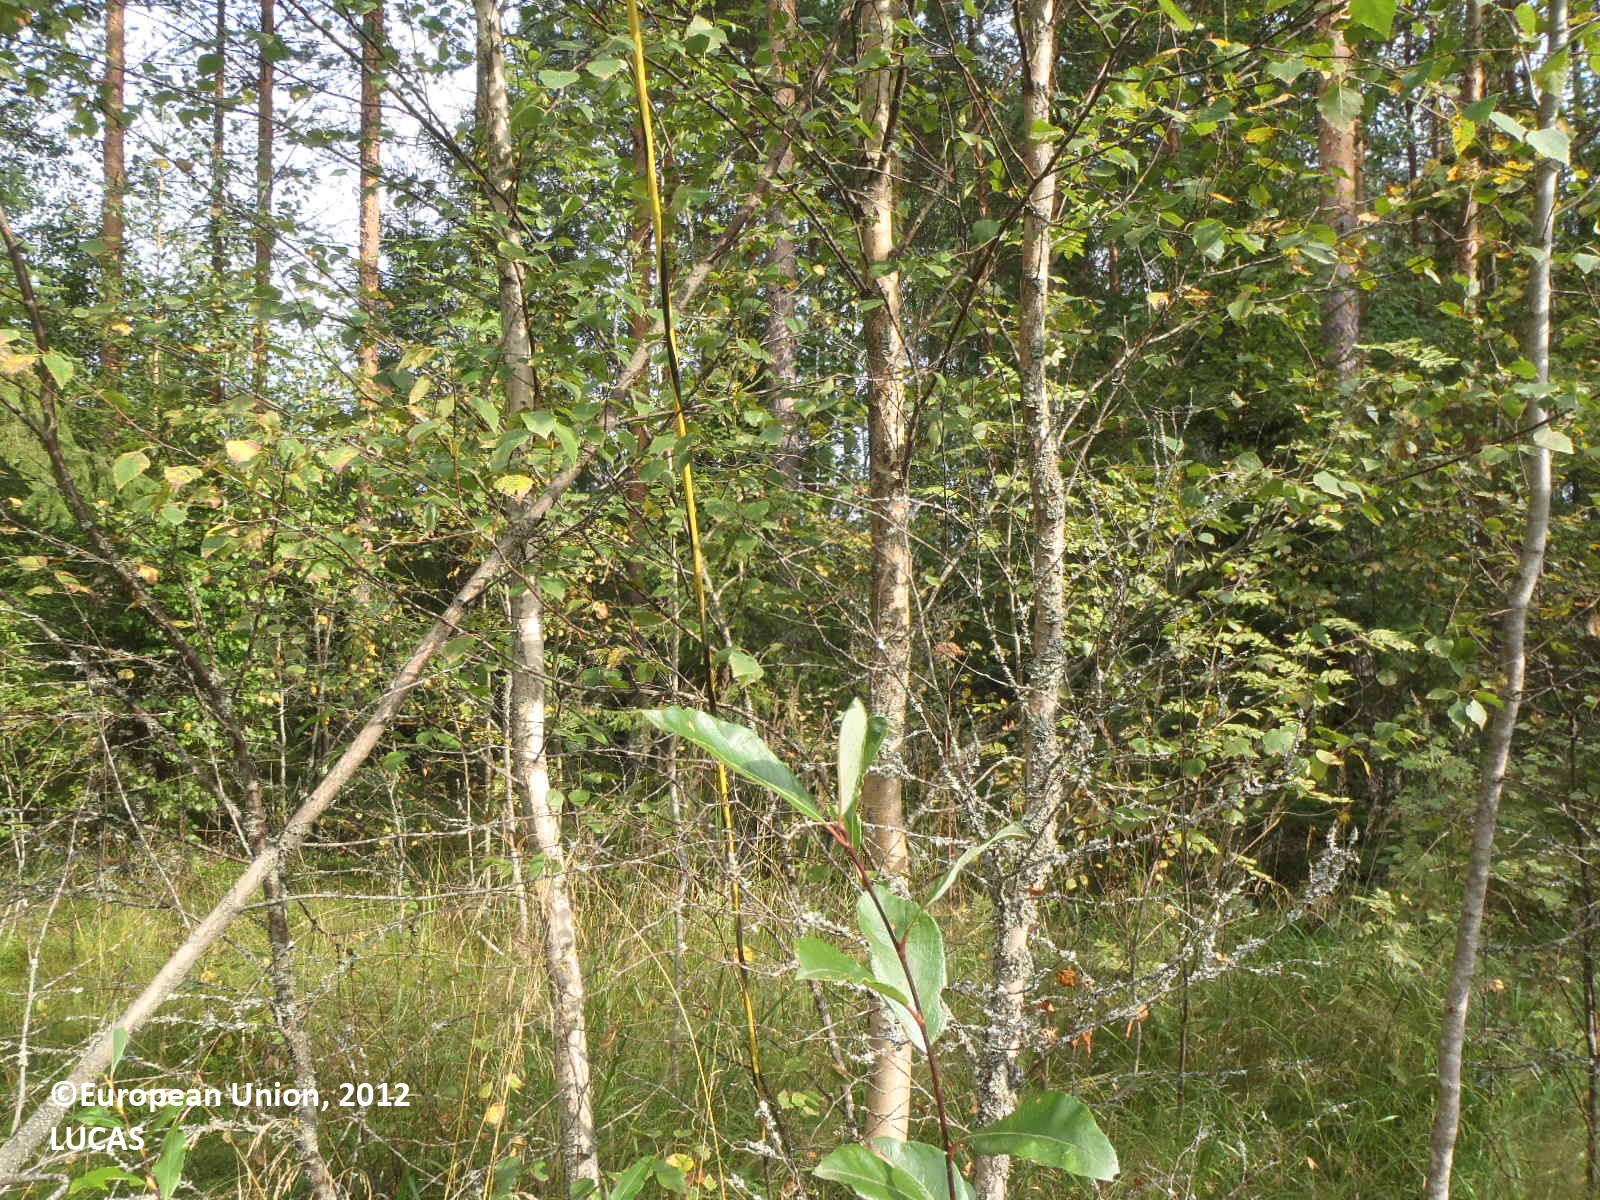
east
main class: Woodland
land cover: Broadleaved woodland
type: boreal forest
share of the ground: > 75 %
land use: Forestry
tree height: > 5 m
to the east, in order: Broadleaved woodland; Pine dominated mixed woodland; Grassland with sparse tree/shrub cover; Ditches and canals; Grassland with sparse tree/shrub cover; Ditches and canals; Grass margins; Paved roads, cycling and walking lanes; Ditches and canals; Grass margins; Temporary grasslands; Ditches and canals; Abandoned hedges; Grass margins; Temporary grasslands; Ditches and canals; Spruce dominated coniferous woodland
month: August
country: FI
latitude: 60.9736
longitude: 22.5011
